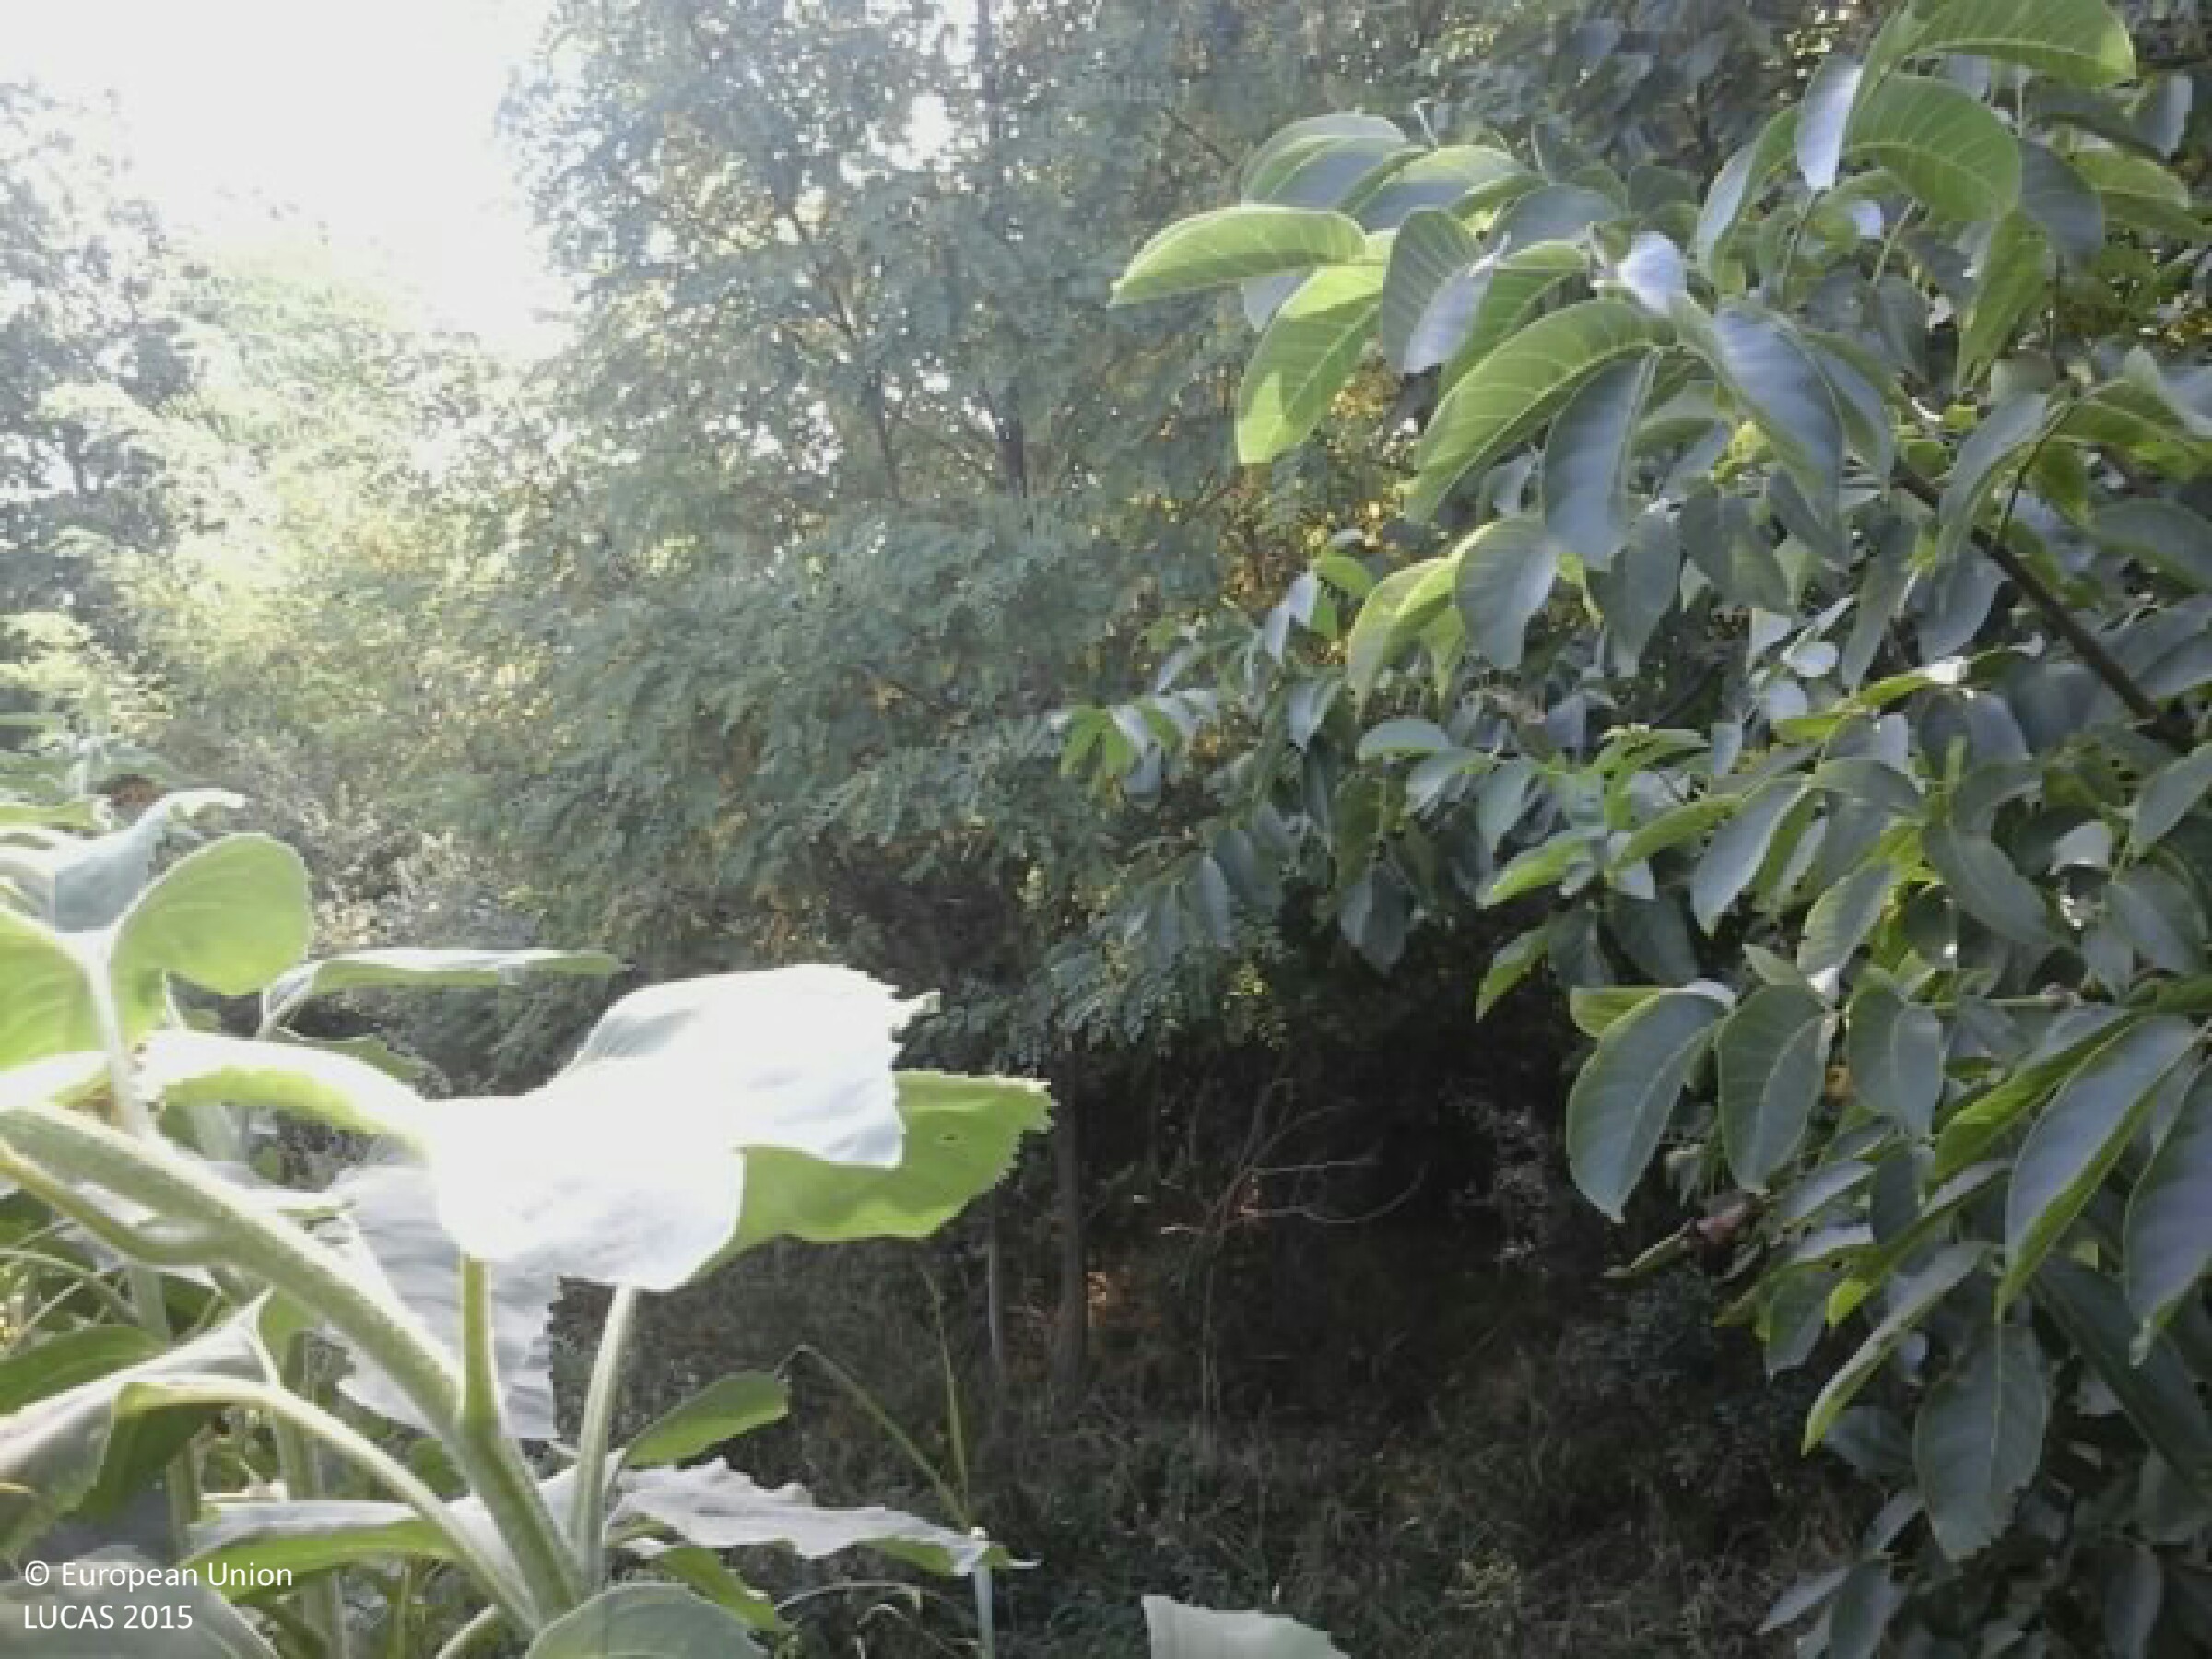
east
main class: Cropland
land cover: Sunflower
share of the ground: > 75 %
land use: Agriculture (excluding fallow land and kitchen gardens)
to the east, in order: Sunflower; Shrubland with sparse tree cover; Tracks; Grass margins; Common wheat; Triticale
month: August
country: HU
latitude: 46.6353
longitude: 18.1730
